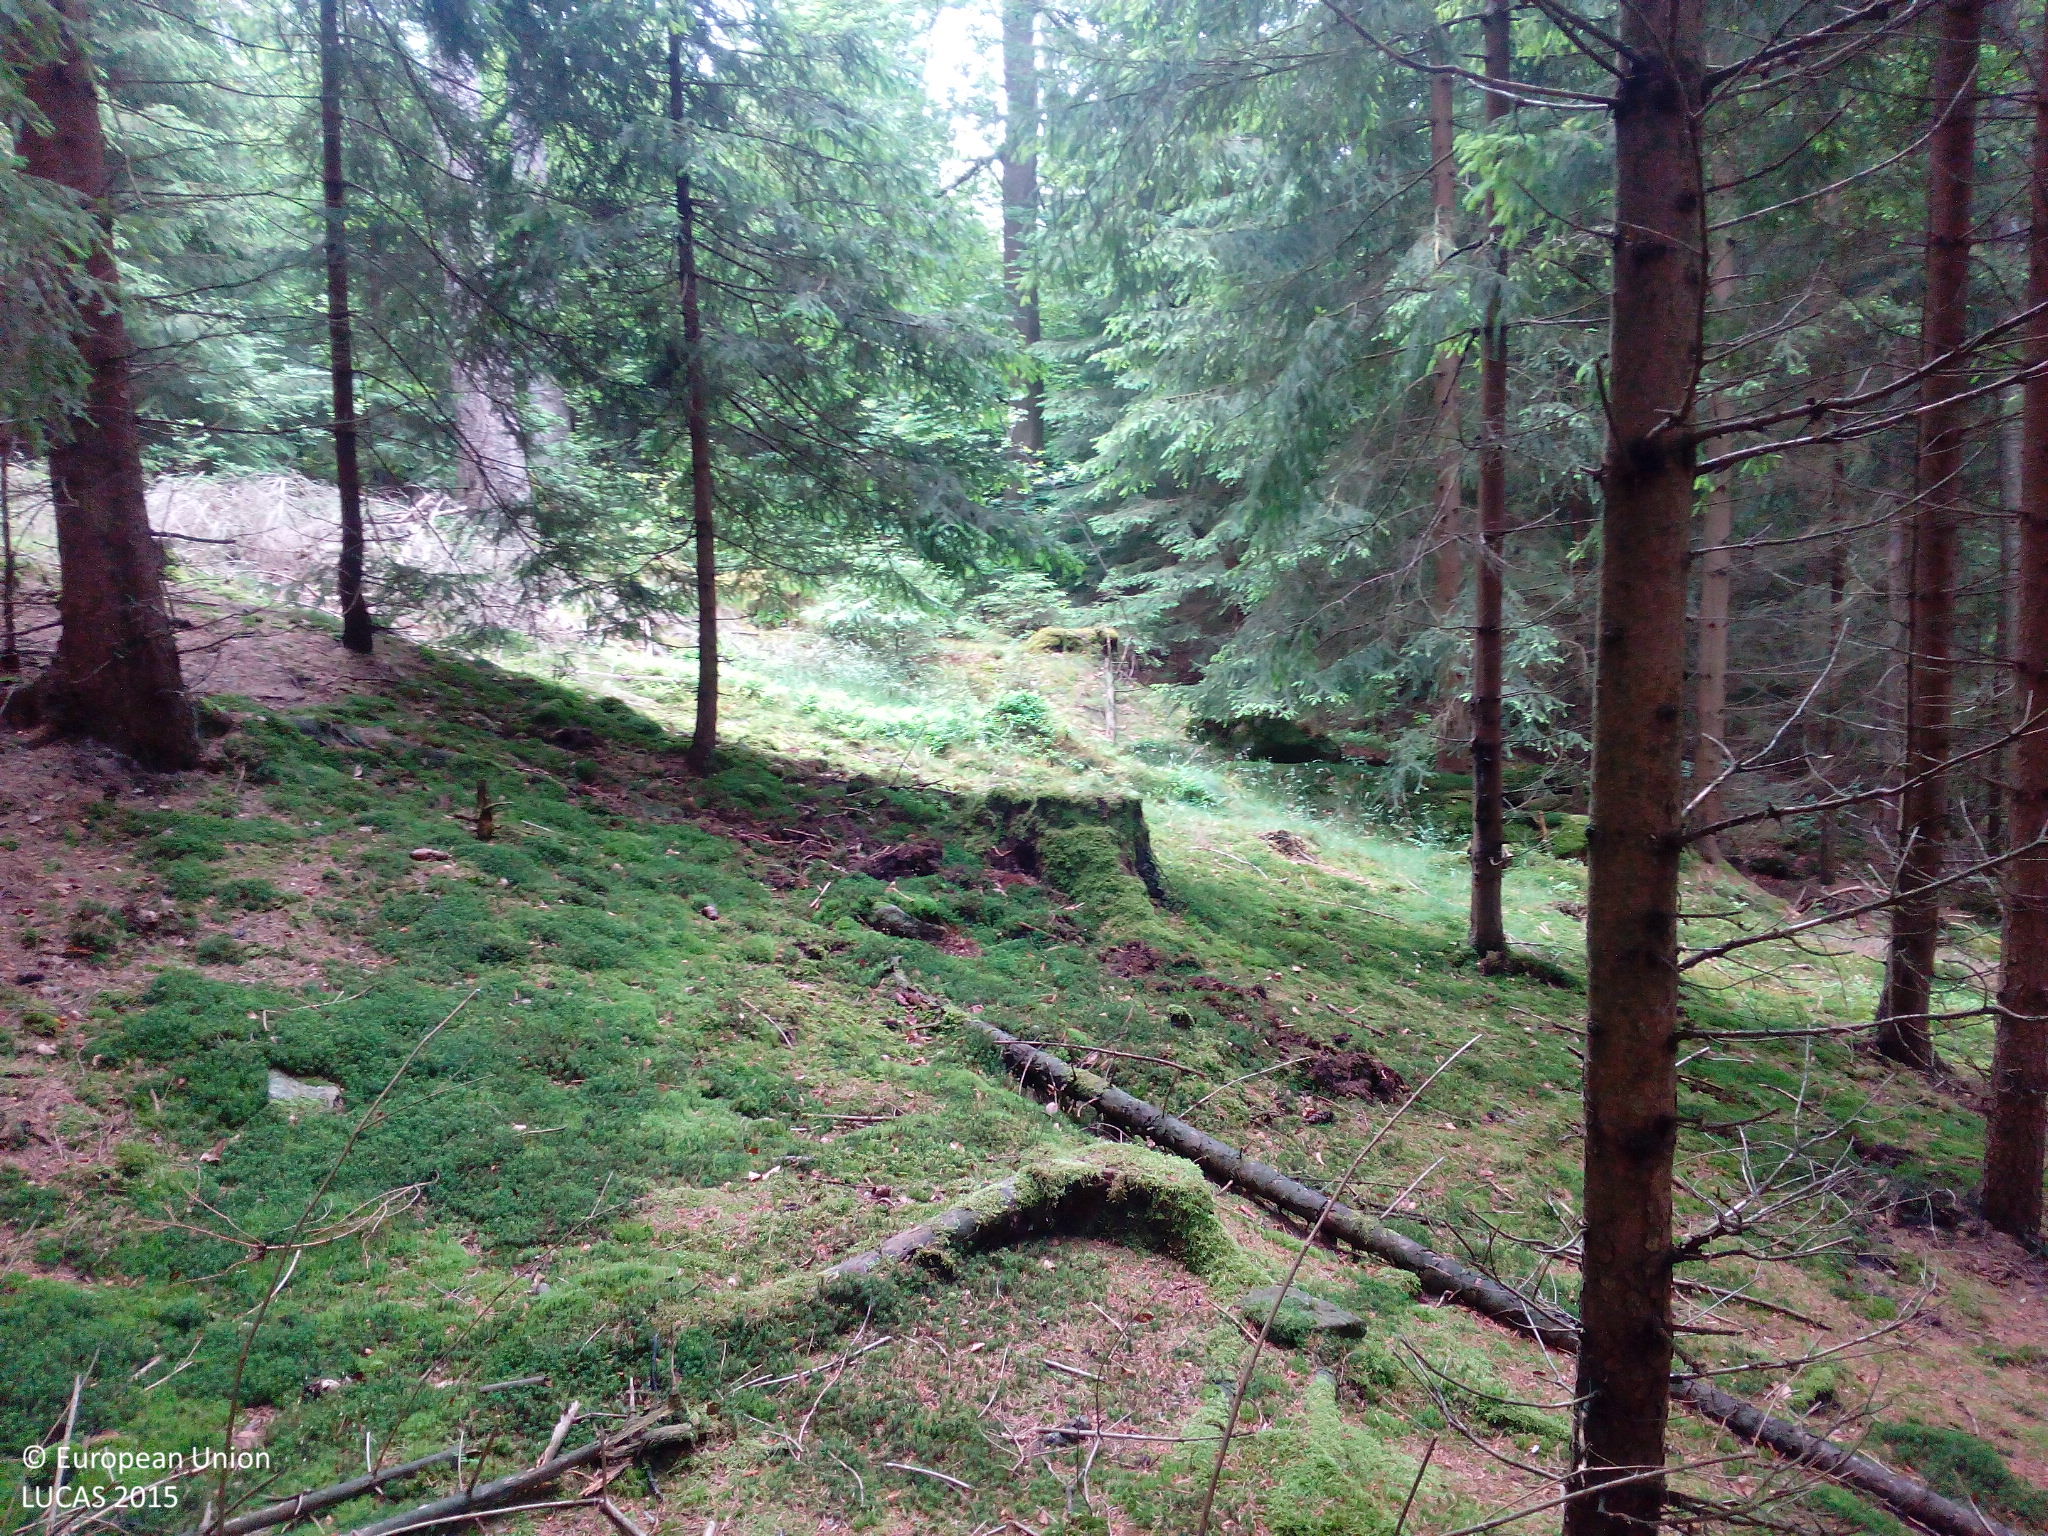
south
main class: Woodland
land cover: Spruce dominated coniferous woodland
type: hemiboreal forest and nemoral coniferous forest and mixed broadleaved-coniferous forest
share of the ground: > 75 %
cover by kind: coniferous forest trees 85 %, lichens and mosses 5 %, consolidated bare surface 5 %, unconsolidated bare surface 5 %
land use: Forestry
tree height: > 5 m
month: June
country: DE
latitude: 49.3851
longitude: 12.4103
